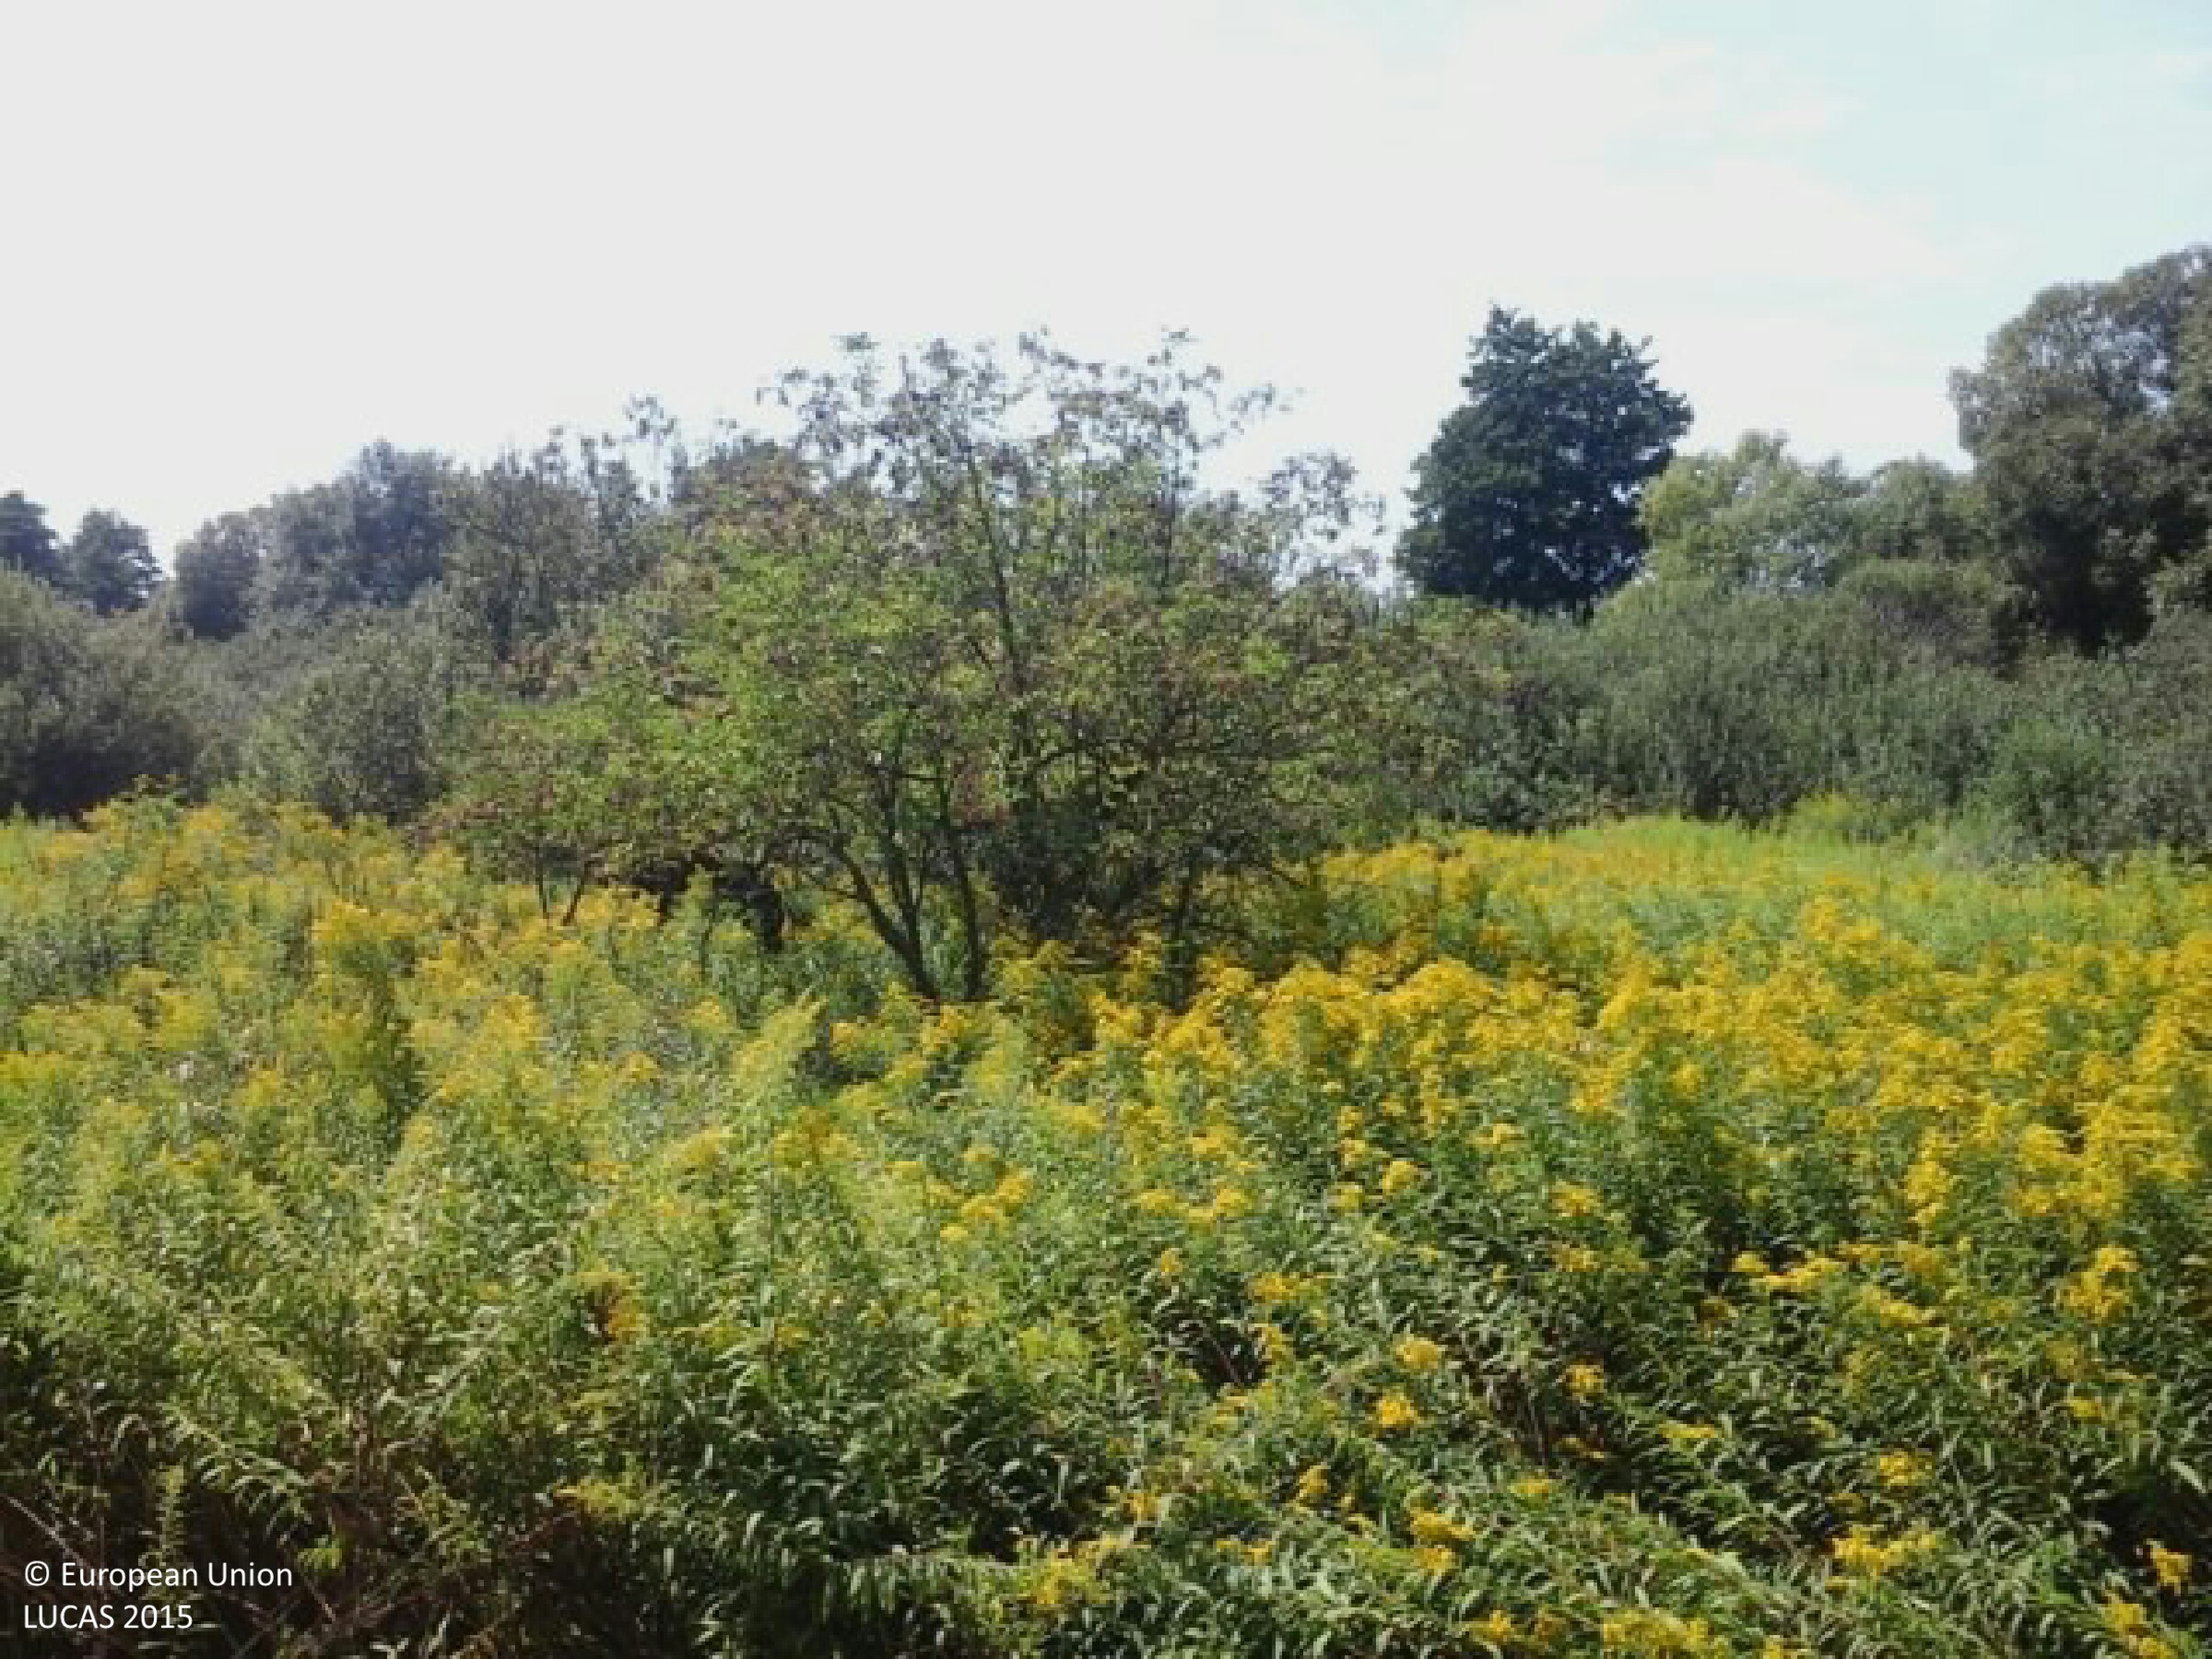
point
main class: Grassland
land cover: Spontaneously vegetated surfaces
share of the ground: > 75 %
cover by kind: herbaceous plants 95 %, shrubs 5 %
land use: Semi-natural and natural areas not in use
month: August
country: HU
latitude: 46.4066
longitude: 17.0662
